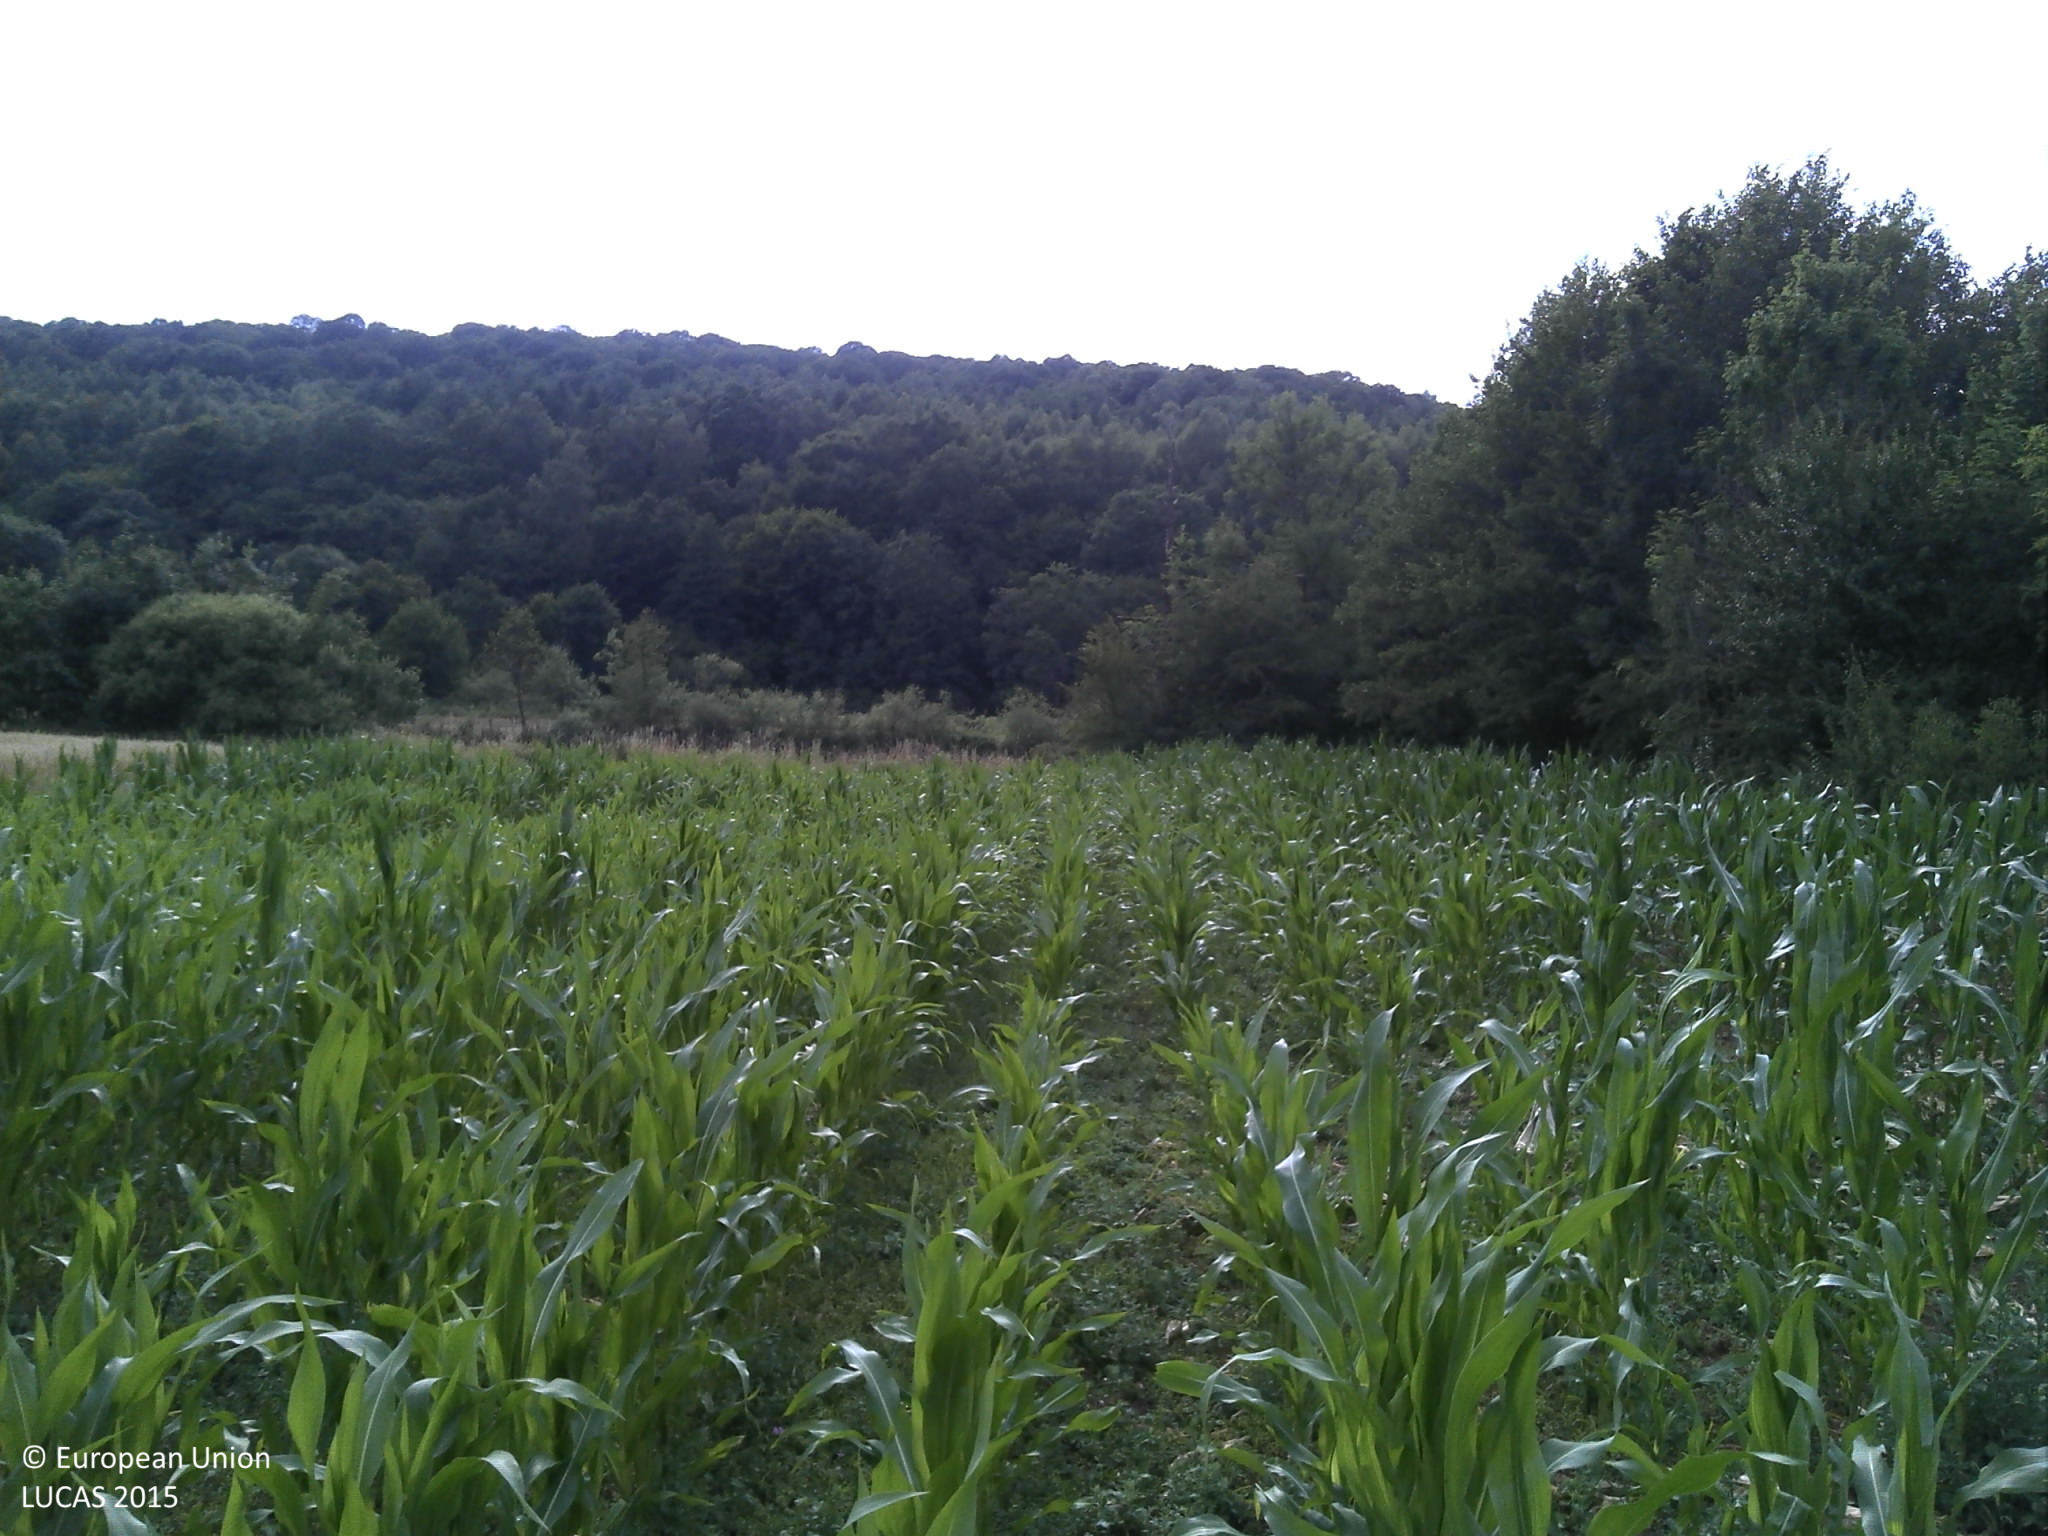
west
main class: Cropland
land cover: Maize
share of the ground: 50 - 75 %
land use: Agriculture (excluding fallow land and kitchen gardens)
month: July
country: FR
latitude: 49.7935
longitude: 4.7597
